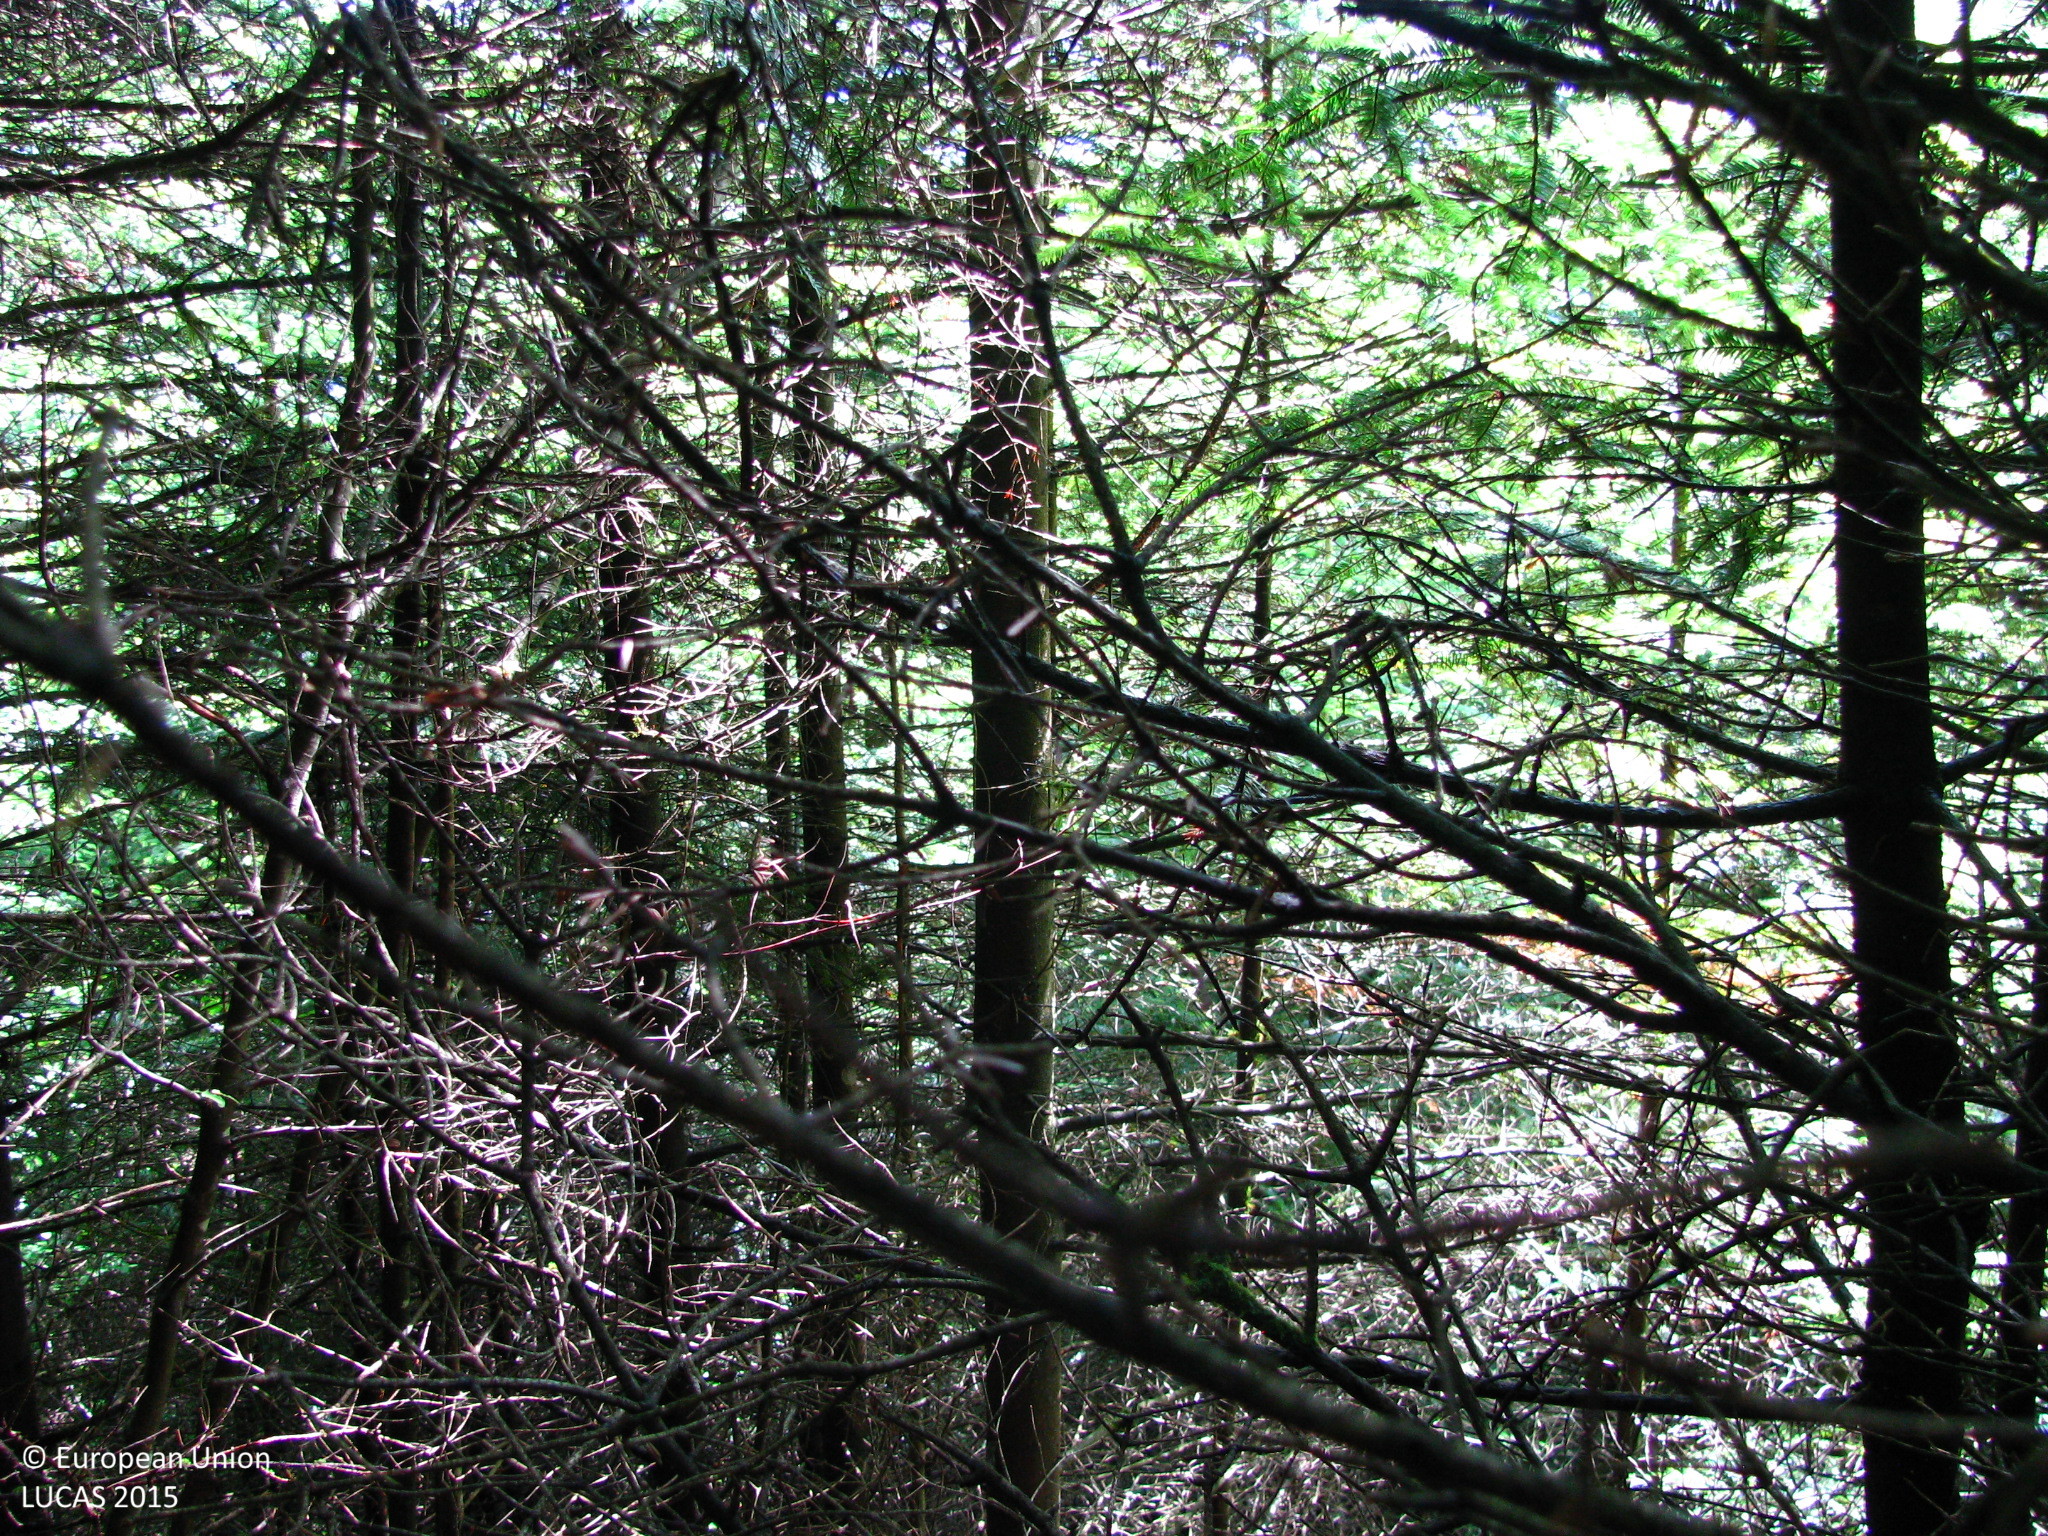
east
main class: Woodland
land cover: Other coniferous woodland
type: alpine coniferous forest
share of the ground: > 75 %
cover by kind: coniferous forest trees 90 %, broadleaved forest trees 5 %, herbaceous plants 5 %
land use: Forestry
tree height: > 5 m
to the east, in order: Other coniferous woodland; Spruce dominated coniferous woodland; Grassland without tree/shrub cover; Shruby margins; Spruce dominated mixed woodland; Broadleaved woodland; Inland fresh running water
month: May
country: AT
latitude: 47.5928
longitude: 14.4543
